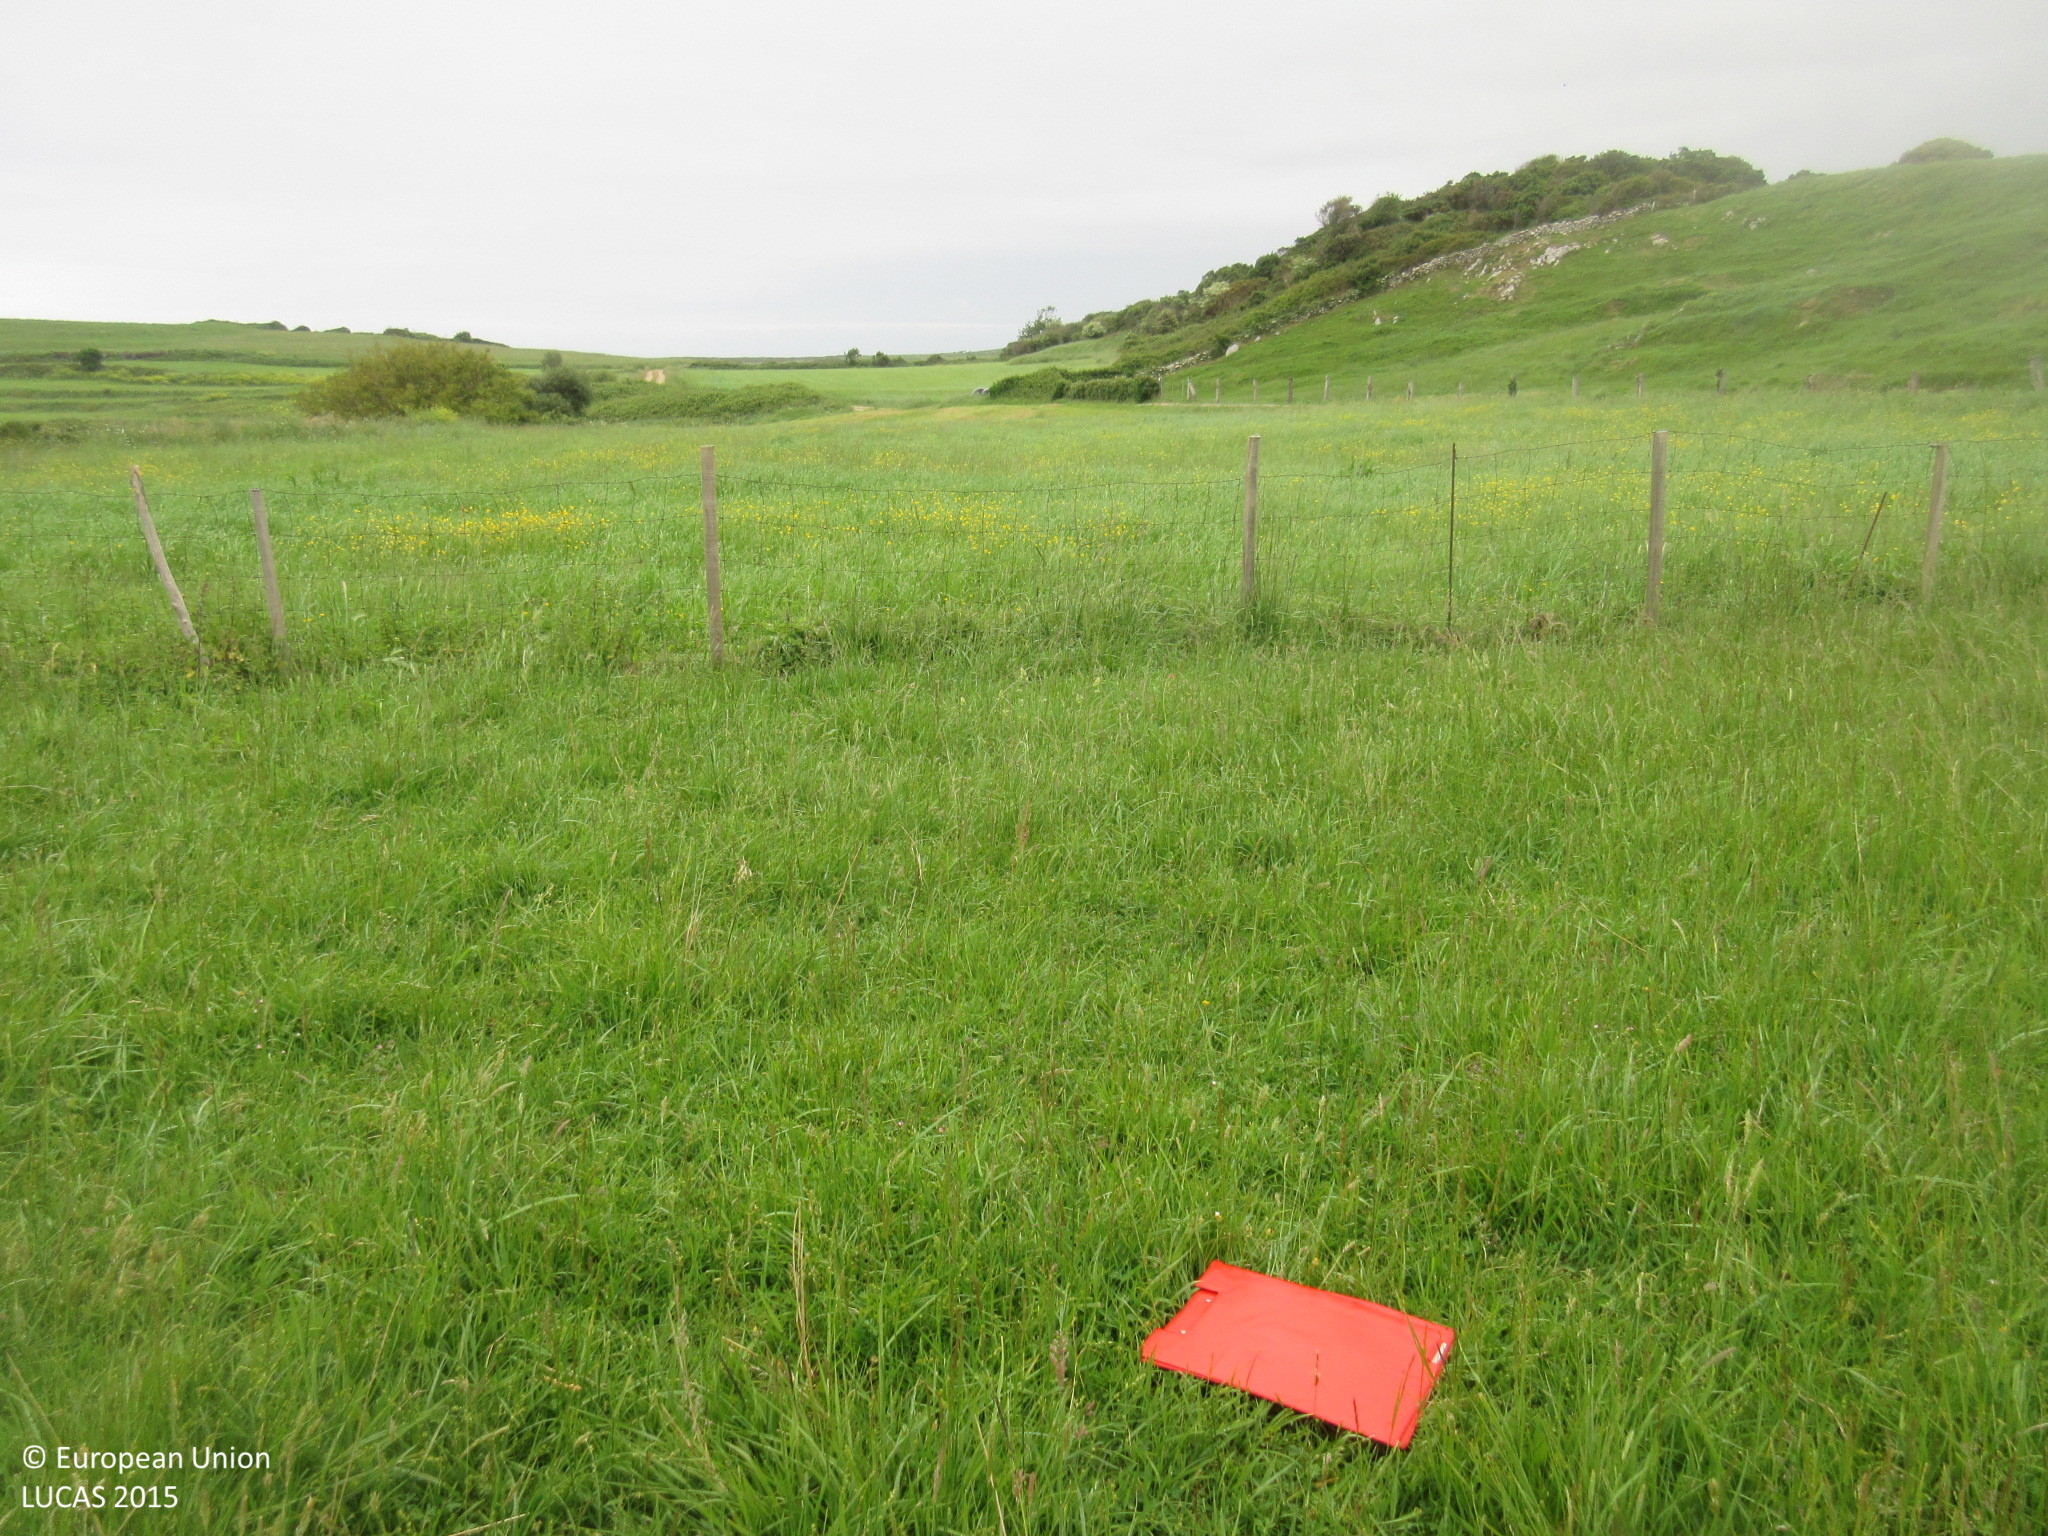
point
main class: Grassland
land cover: Grassland without tree/shrub cover
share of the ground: > 75 %
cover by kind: herbaceous plants 100 %
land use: Agriculture (excluding fallow land and kitchen gardens)
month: May
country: ES
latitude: 43.3891
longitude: -4.4412
